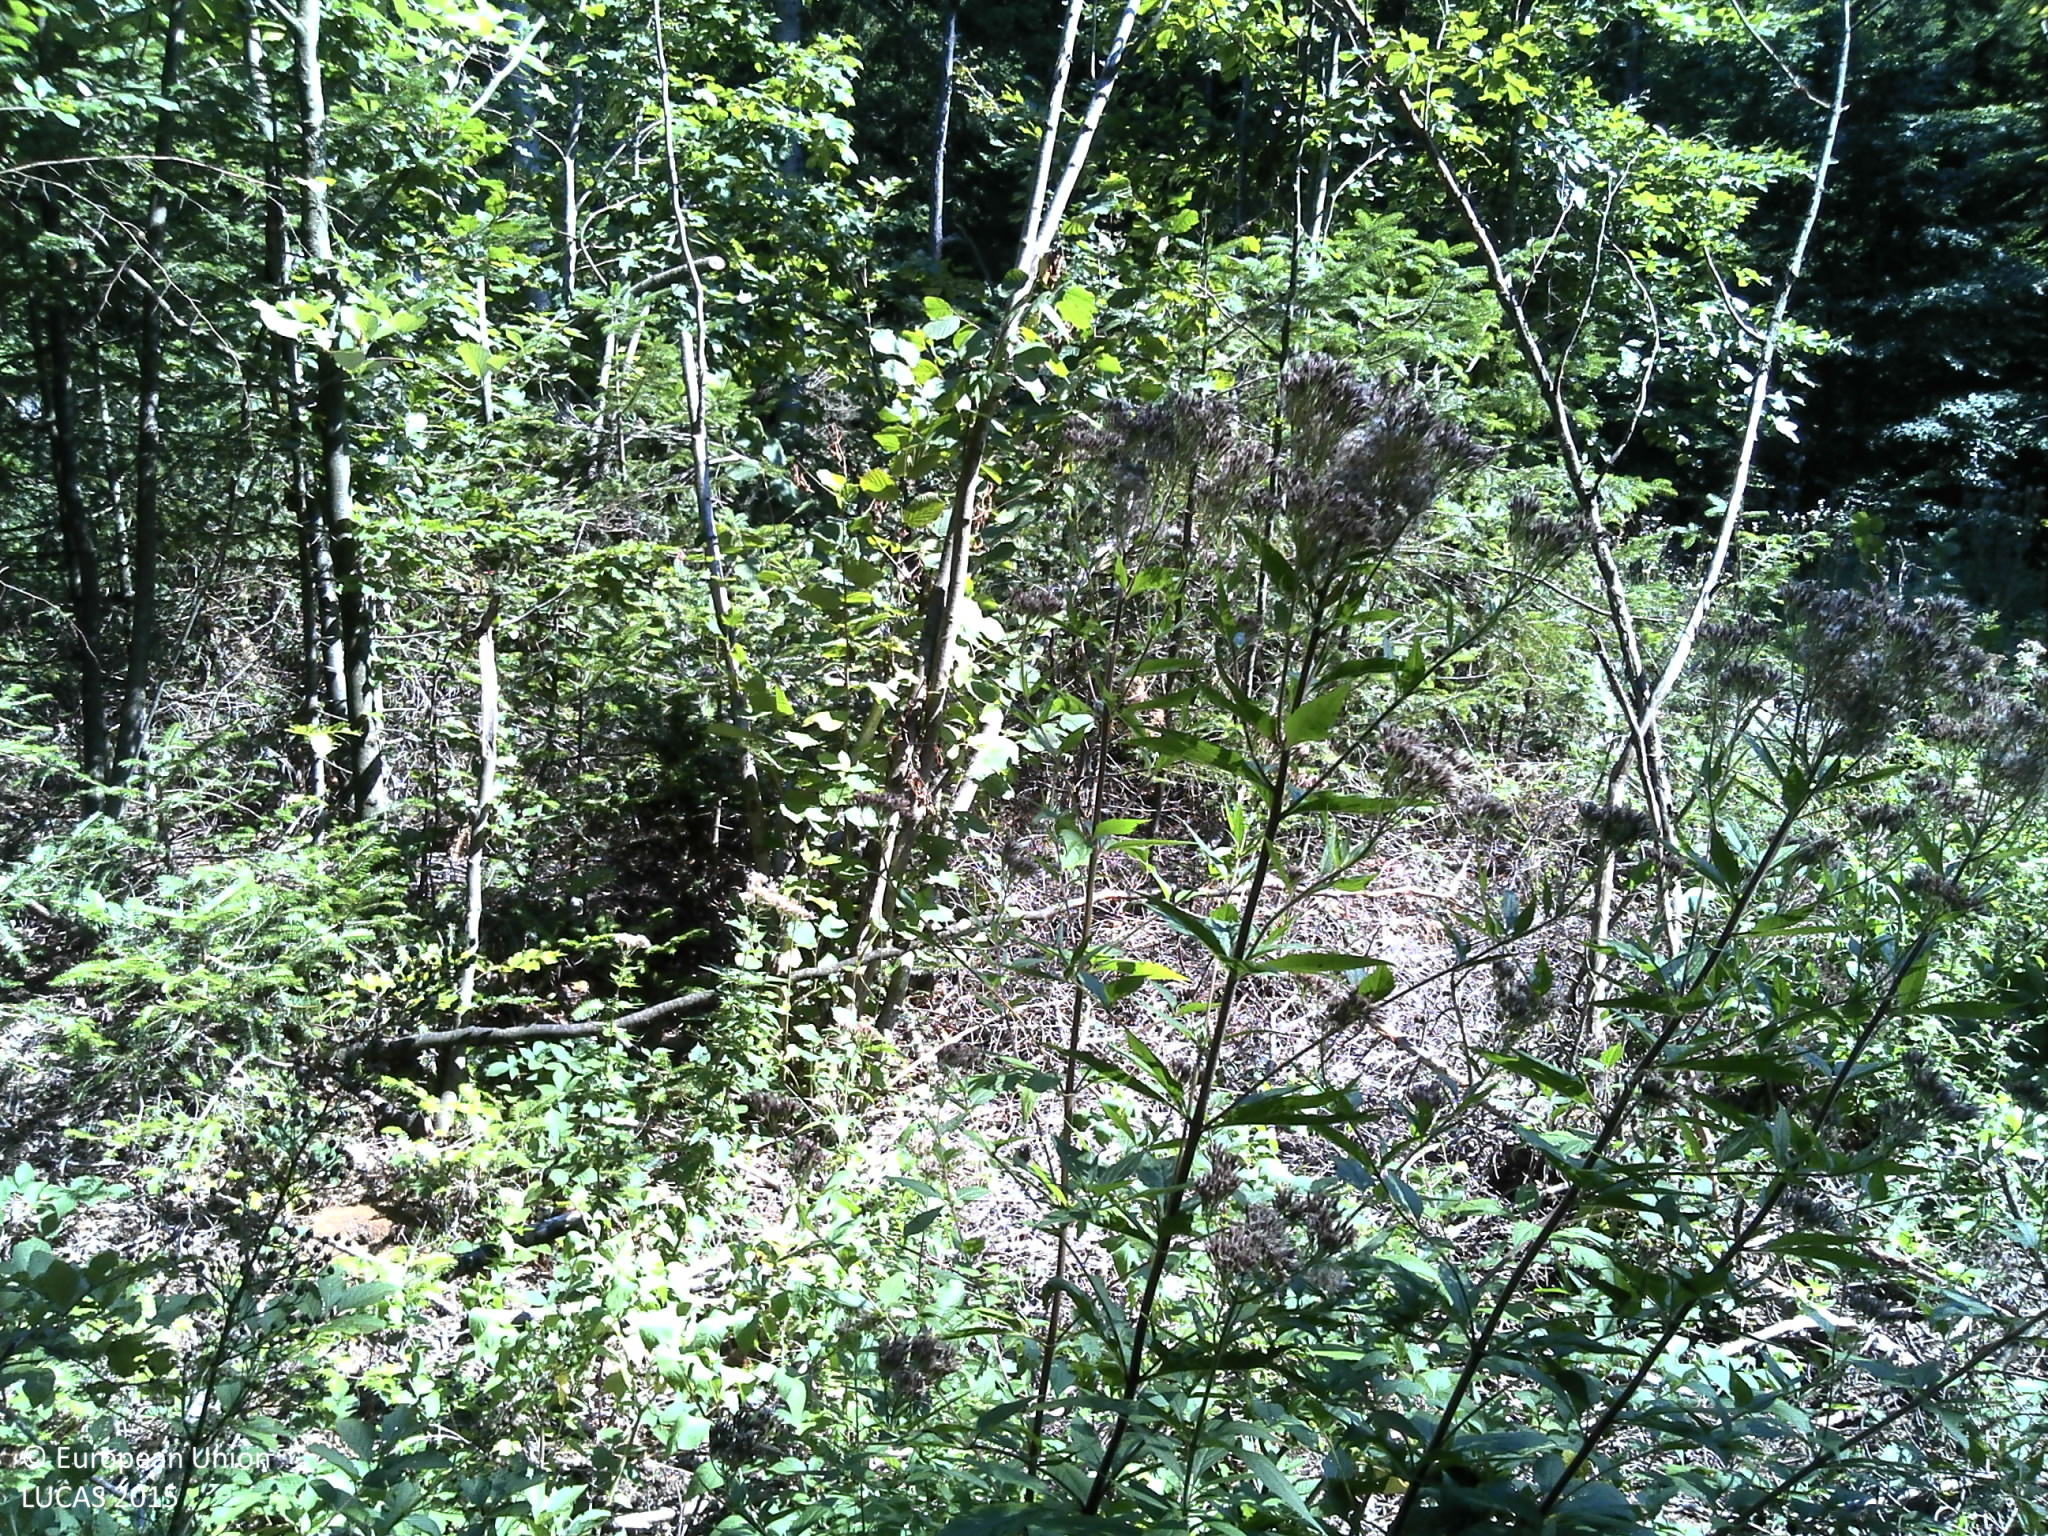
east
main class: Woodland
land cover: Pine dominated coniferous woodland
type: coniferous forest of the mediterranean region
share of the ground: > 75 %
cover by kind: coniferous forest trees 100 %
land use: Forestry
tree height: > 5 m
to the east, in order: Pine dominated coniferous woodland; Paved roads, cycling and walking lanes; Pine dominated coniferous woodland
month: August
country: HR
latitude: 45.1597
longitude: 15.1979
